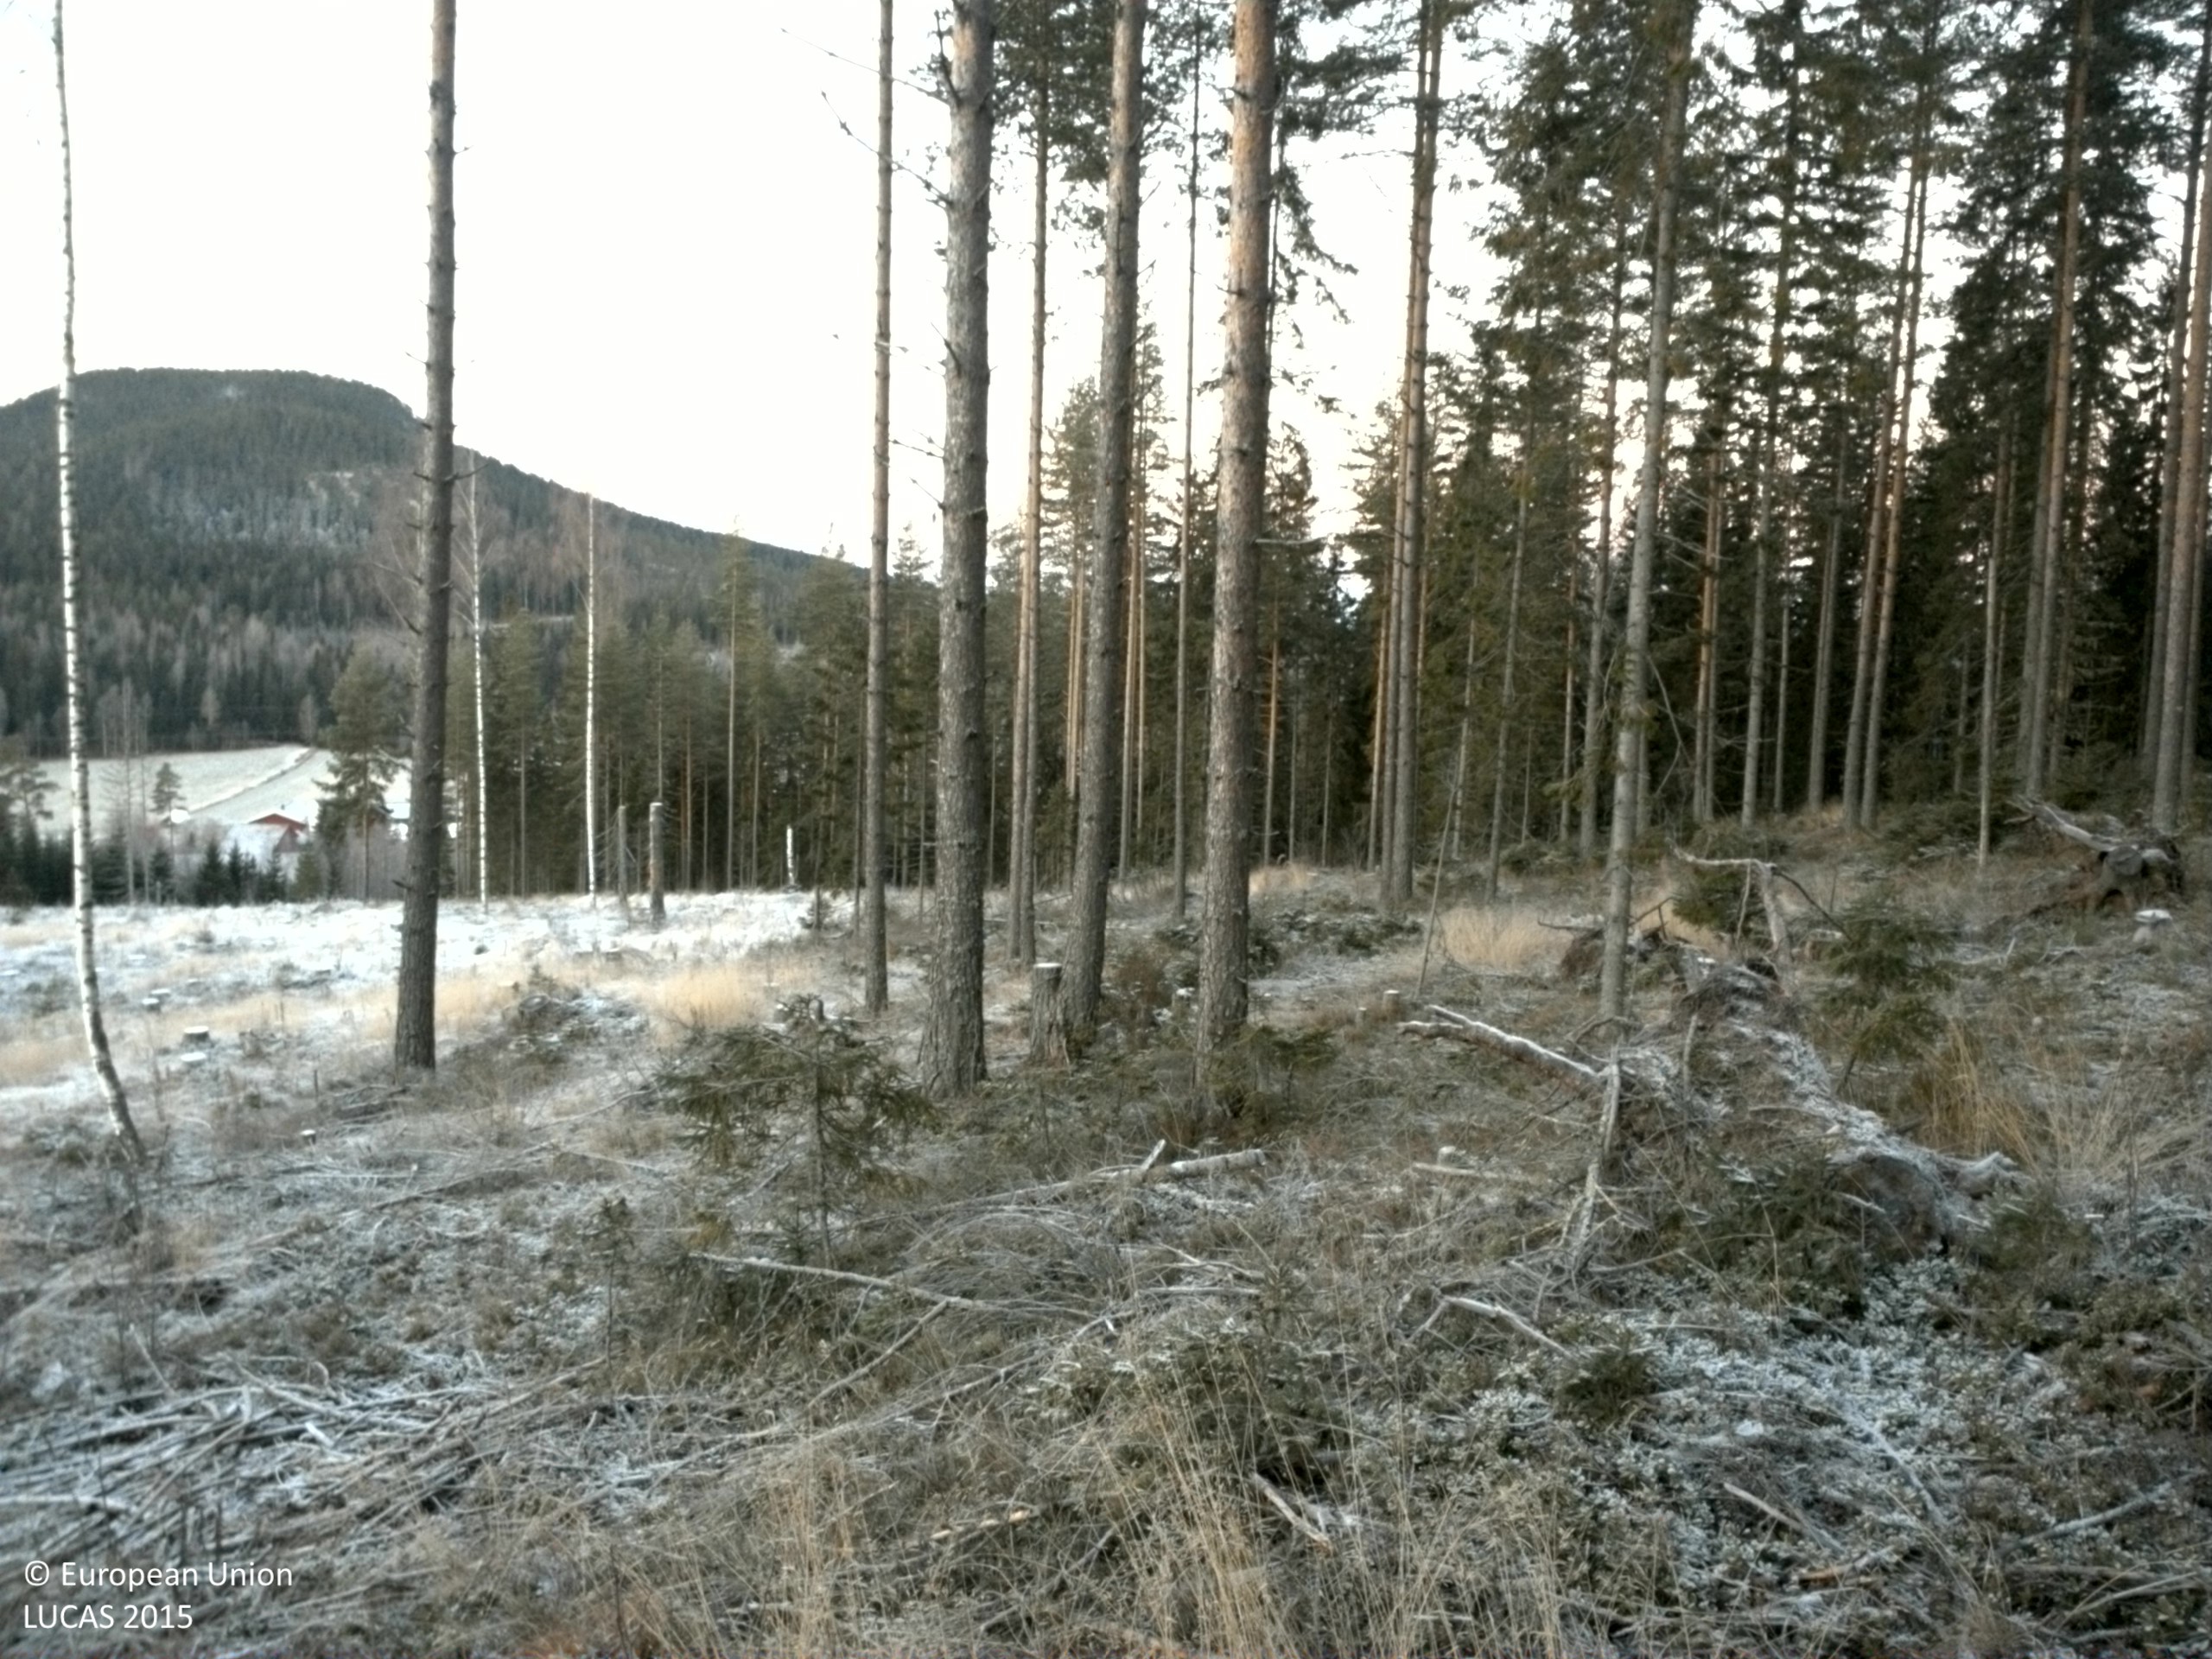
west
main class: Woodland
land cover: Other mixed woodland
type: boreal forest
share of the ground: 10 - 25 %
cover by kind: herbaceous plants 35 %, shrubs 25 %, lichens and mosses 25 %, coniferous forest trees 10 %, broadleaved forest trees 5 %
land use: Forestry
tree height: < 5 m
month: November
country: SE
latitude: 61.7394
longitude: 16.2873
